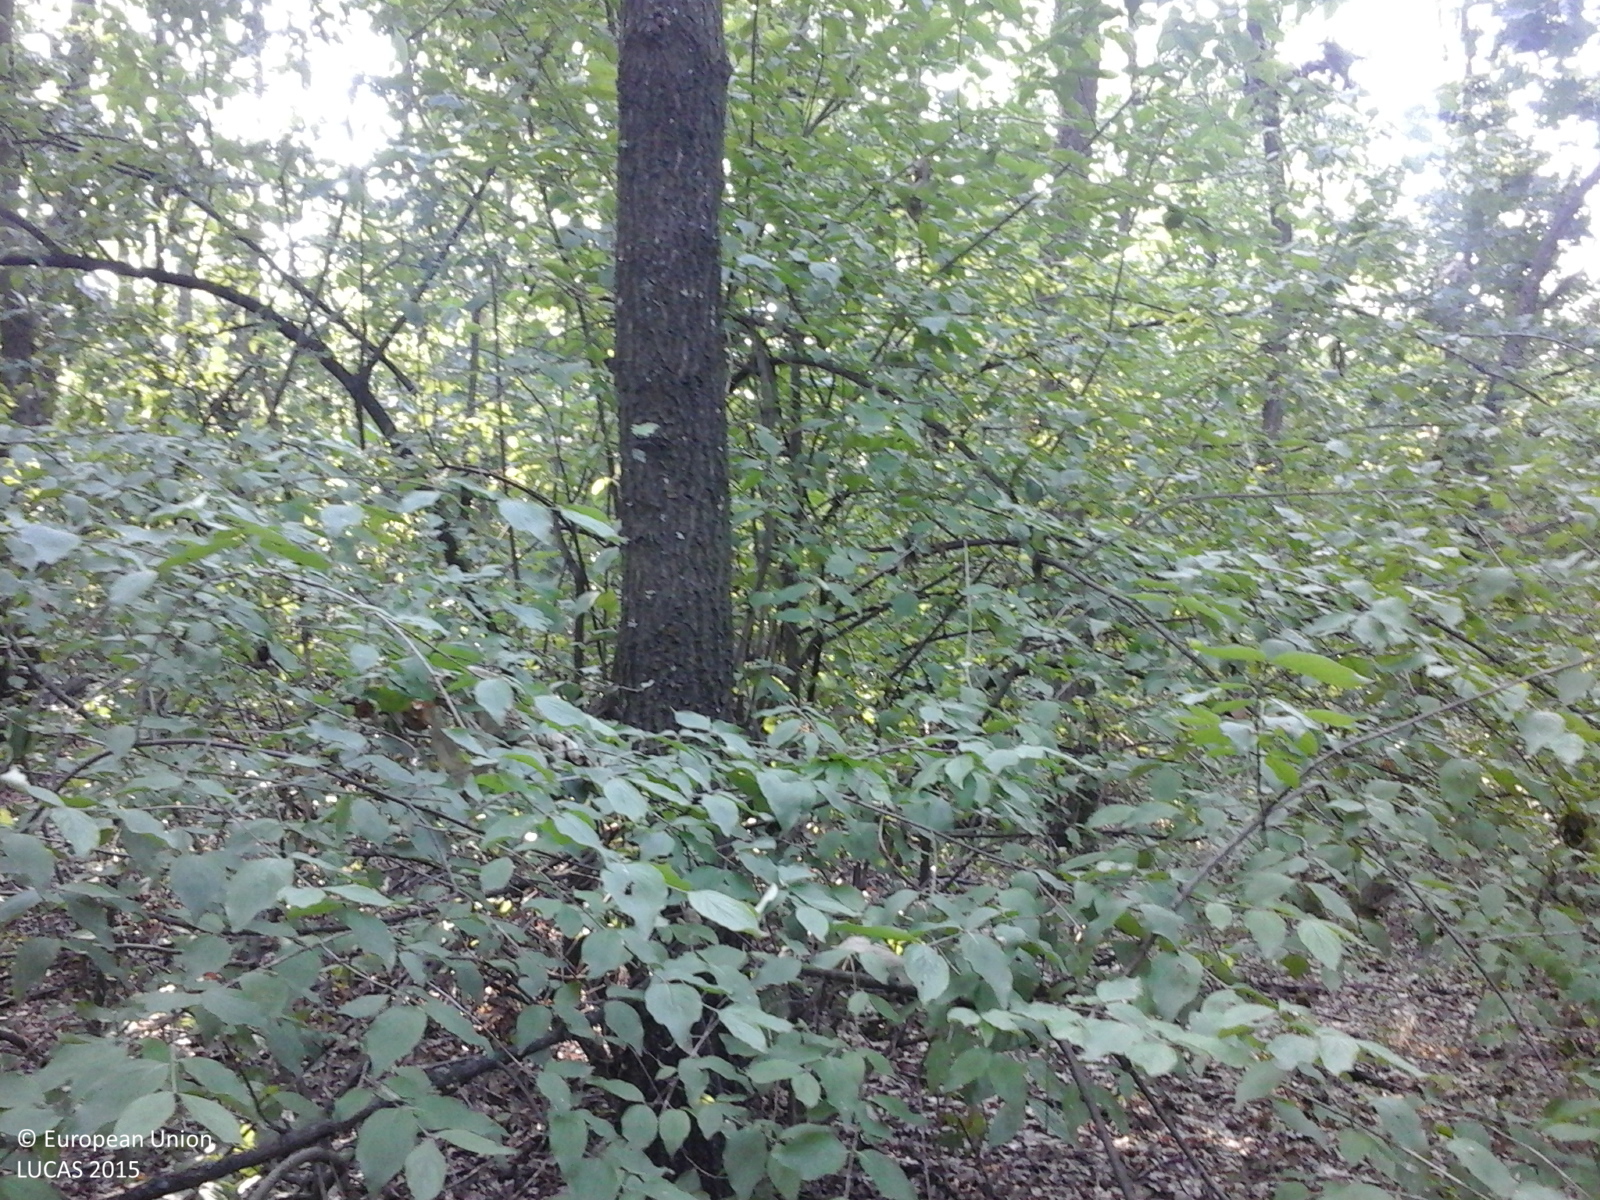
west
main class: Woodland
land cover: Broadleaved woodland
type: acidophilous oak and oak-birch forest
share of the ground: > 75 %
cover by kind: broadleaved forest trees 100 %
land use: Forestry
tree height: > 5 m
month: September
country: RO
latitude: 47.2483
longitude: 22.7030
